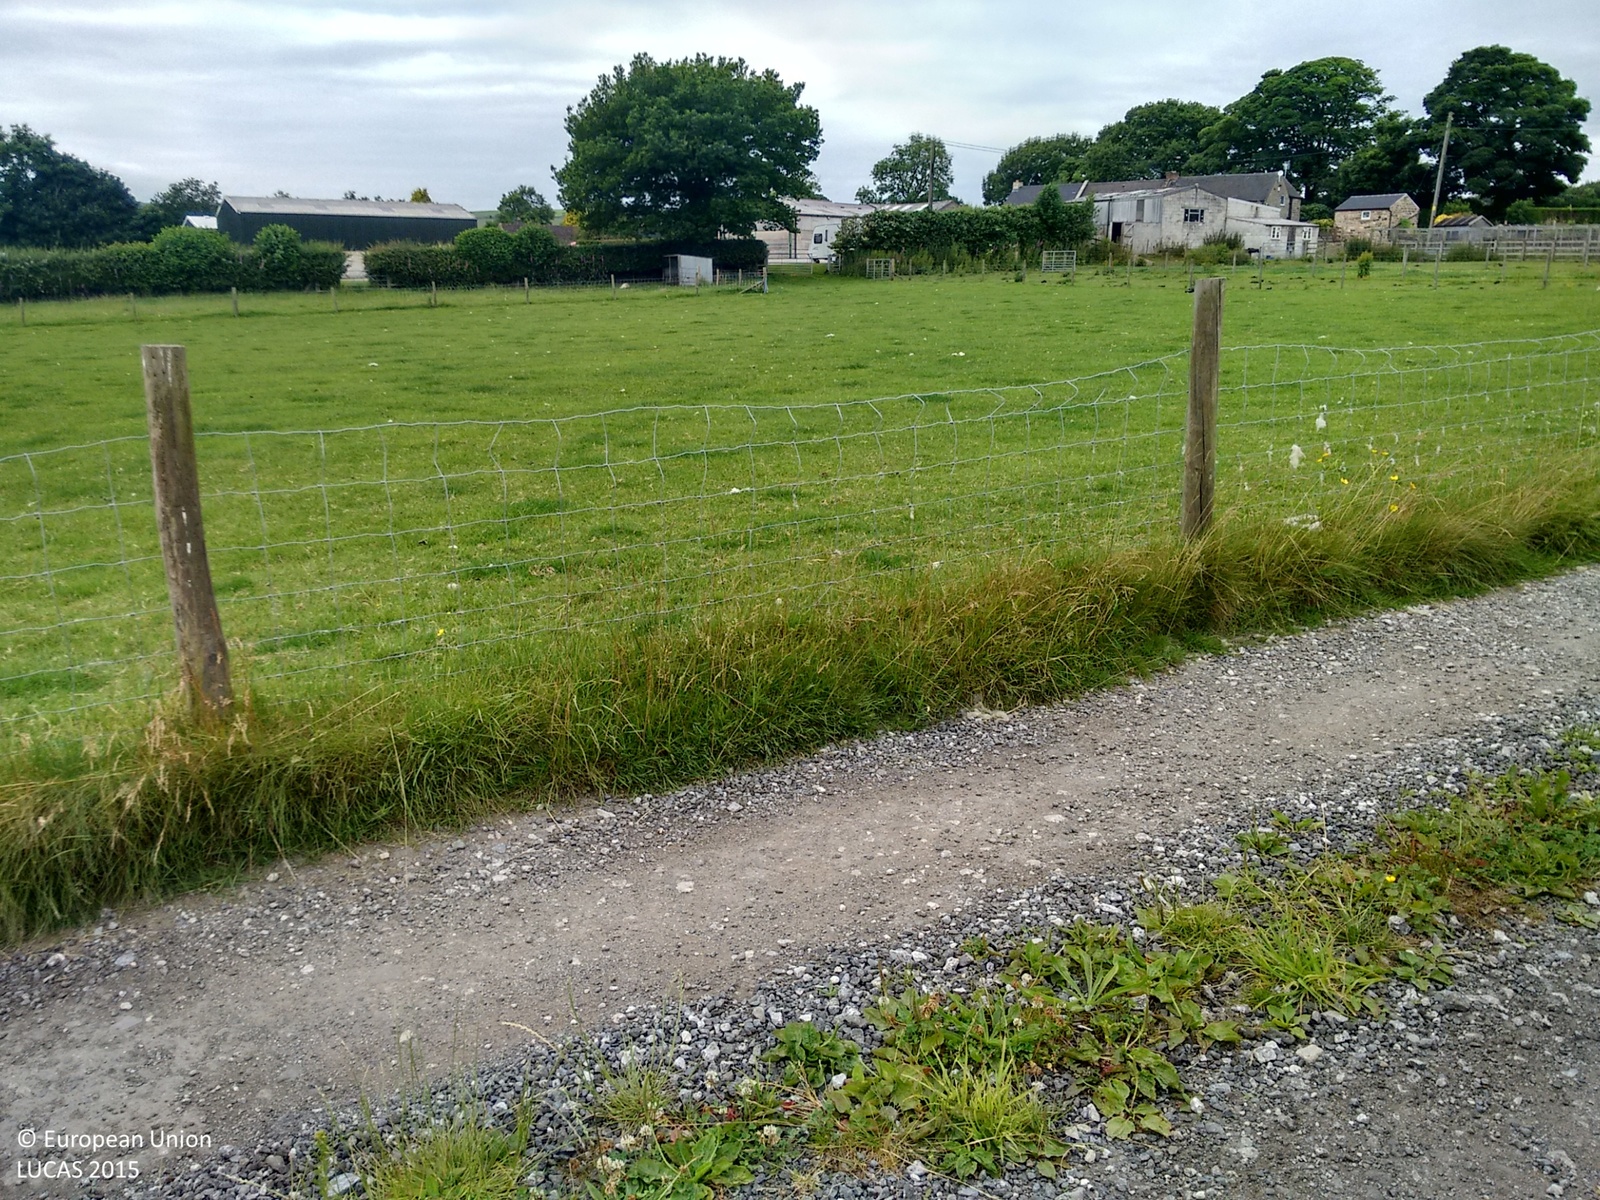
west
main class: Grassland
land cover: Grassland without tree/shrub cover
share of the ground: > 75 %
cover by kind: herbaceous plants 100 %
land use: Agriculture (excluding fallow land and kitchen gardens)
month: July
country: GB
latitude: 53.1113
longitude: -1.4483
